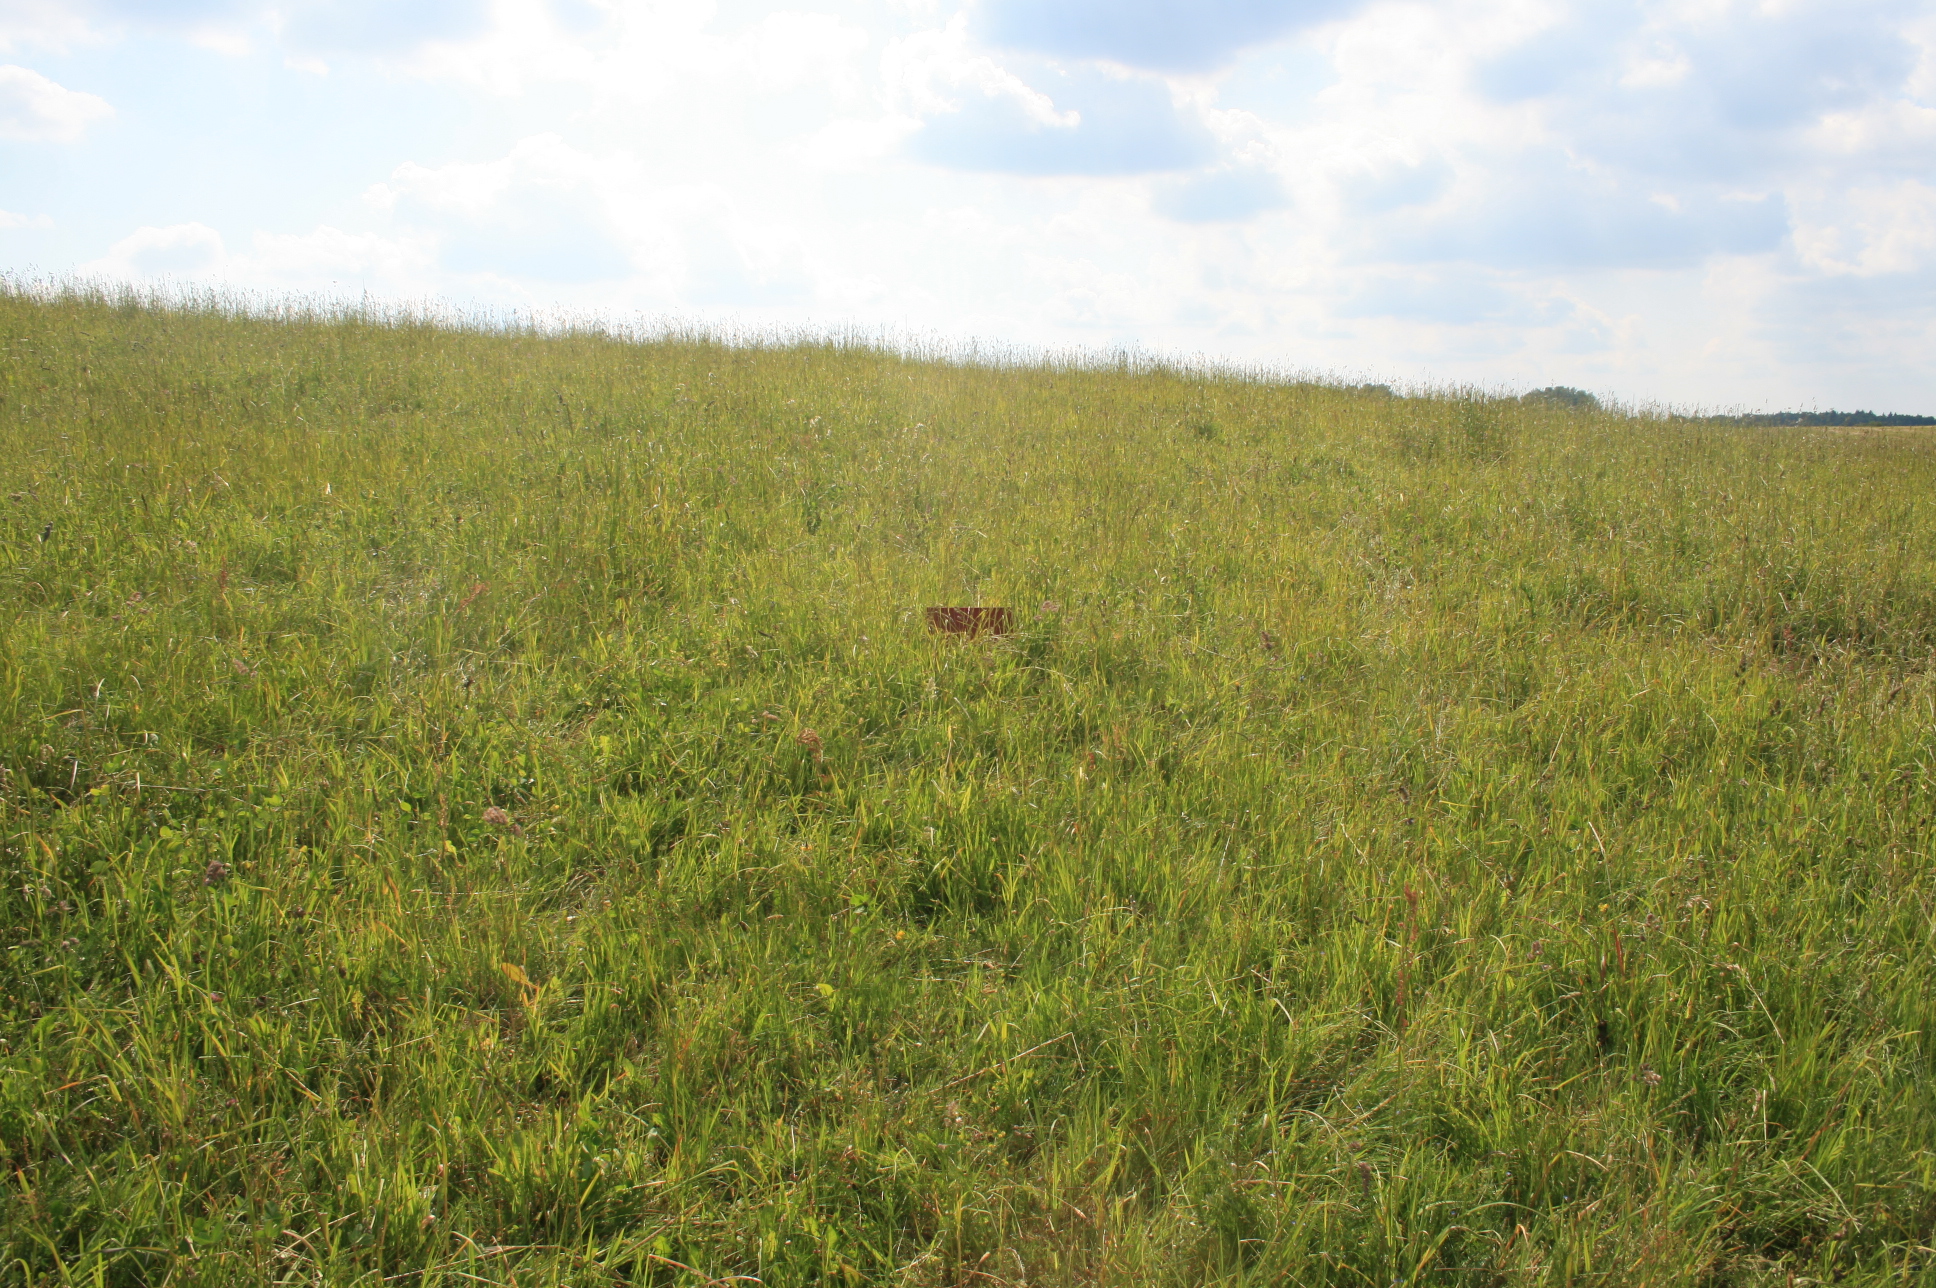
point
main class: Grassland
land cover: Grassland without tree/shrub cover
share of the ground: > 75 %
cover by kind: herbaceous plants 100 %
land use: Agriculture (excluding fallow land and kitchen gardens)
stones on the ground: < 10 %
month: June
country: LT
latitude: 55.6239
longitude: 22.1722
